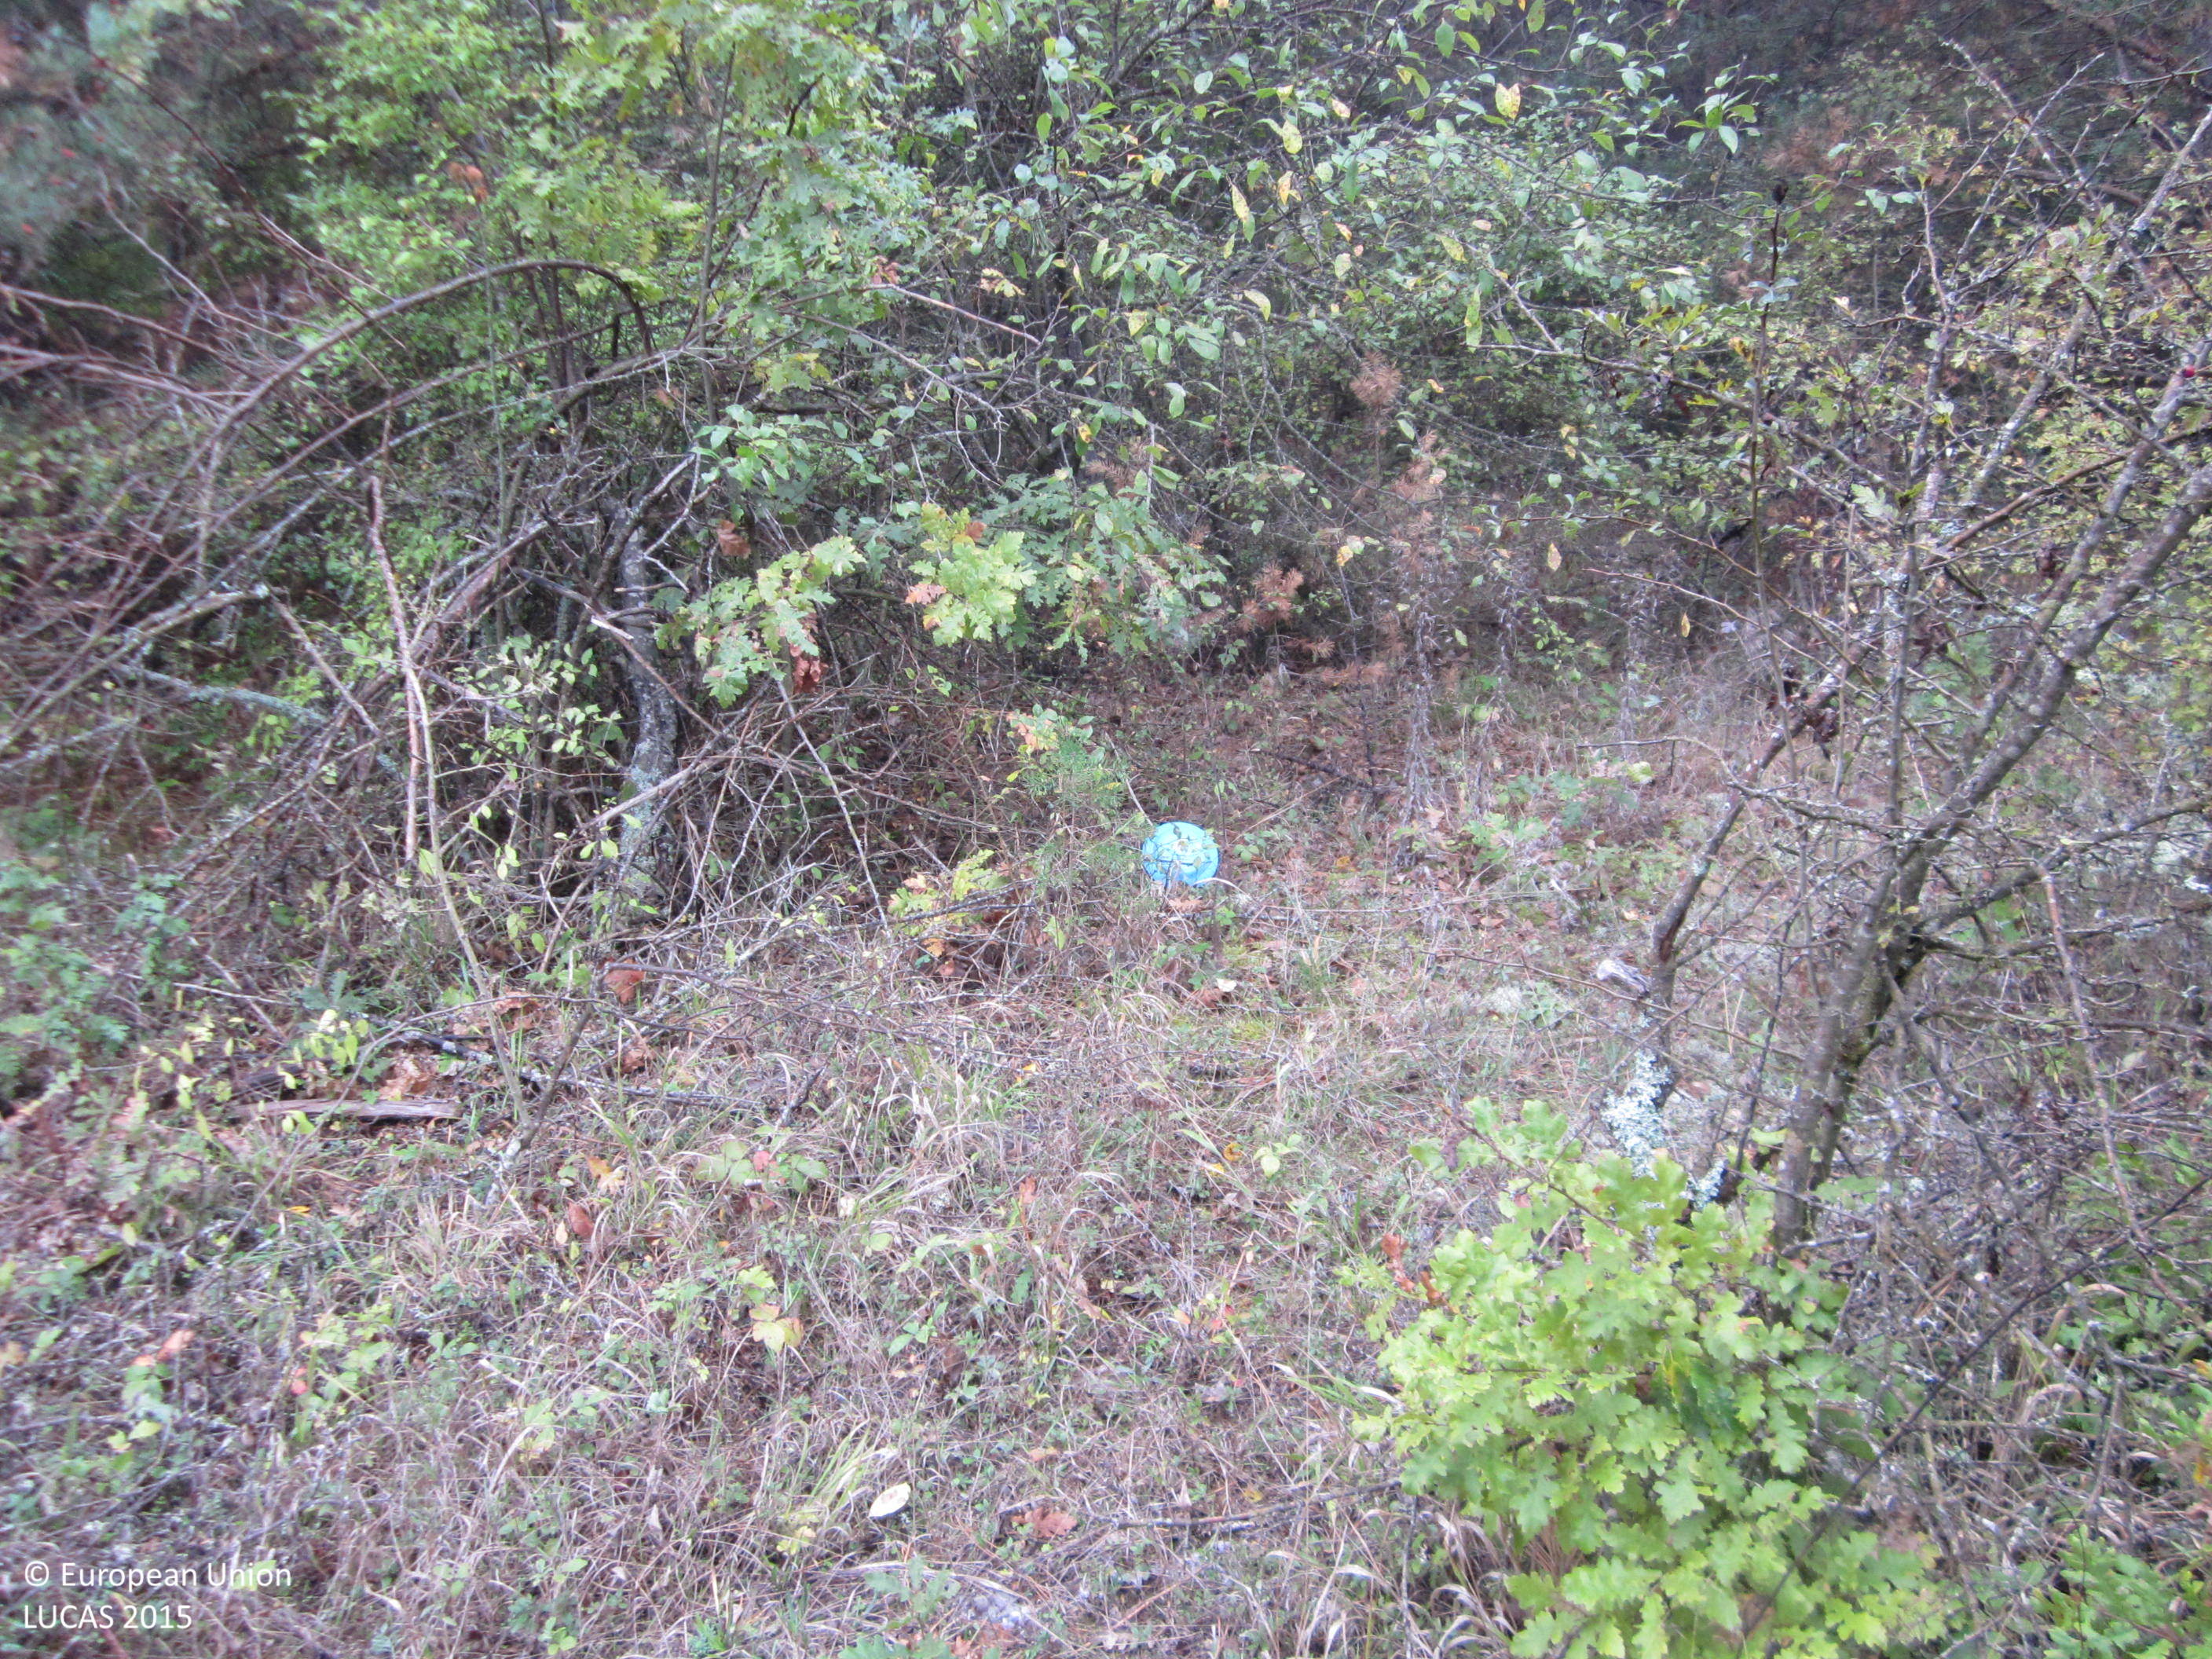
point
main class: Woodland
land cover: Pine dominated mixed woodland
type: hemiboreal forest and nemoral coniferous forest and mixed broadleaved-coniferous forest
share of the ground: > 75 %
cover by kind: coniferous forest trees 50 %, broadleaved forest trees 30 %, shrubs 10 %, herbaceous plants 10 %
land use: Forestry
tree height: > 5 m
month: October
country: BG
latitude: 42.1157
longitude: 27.2687
